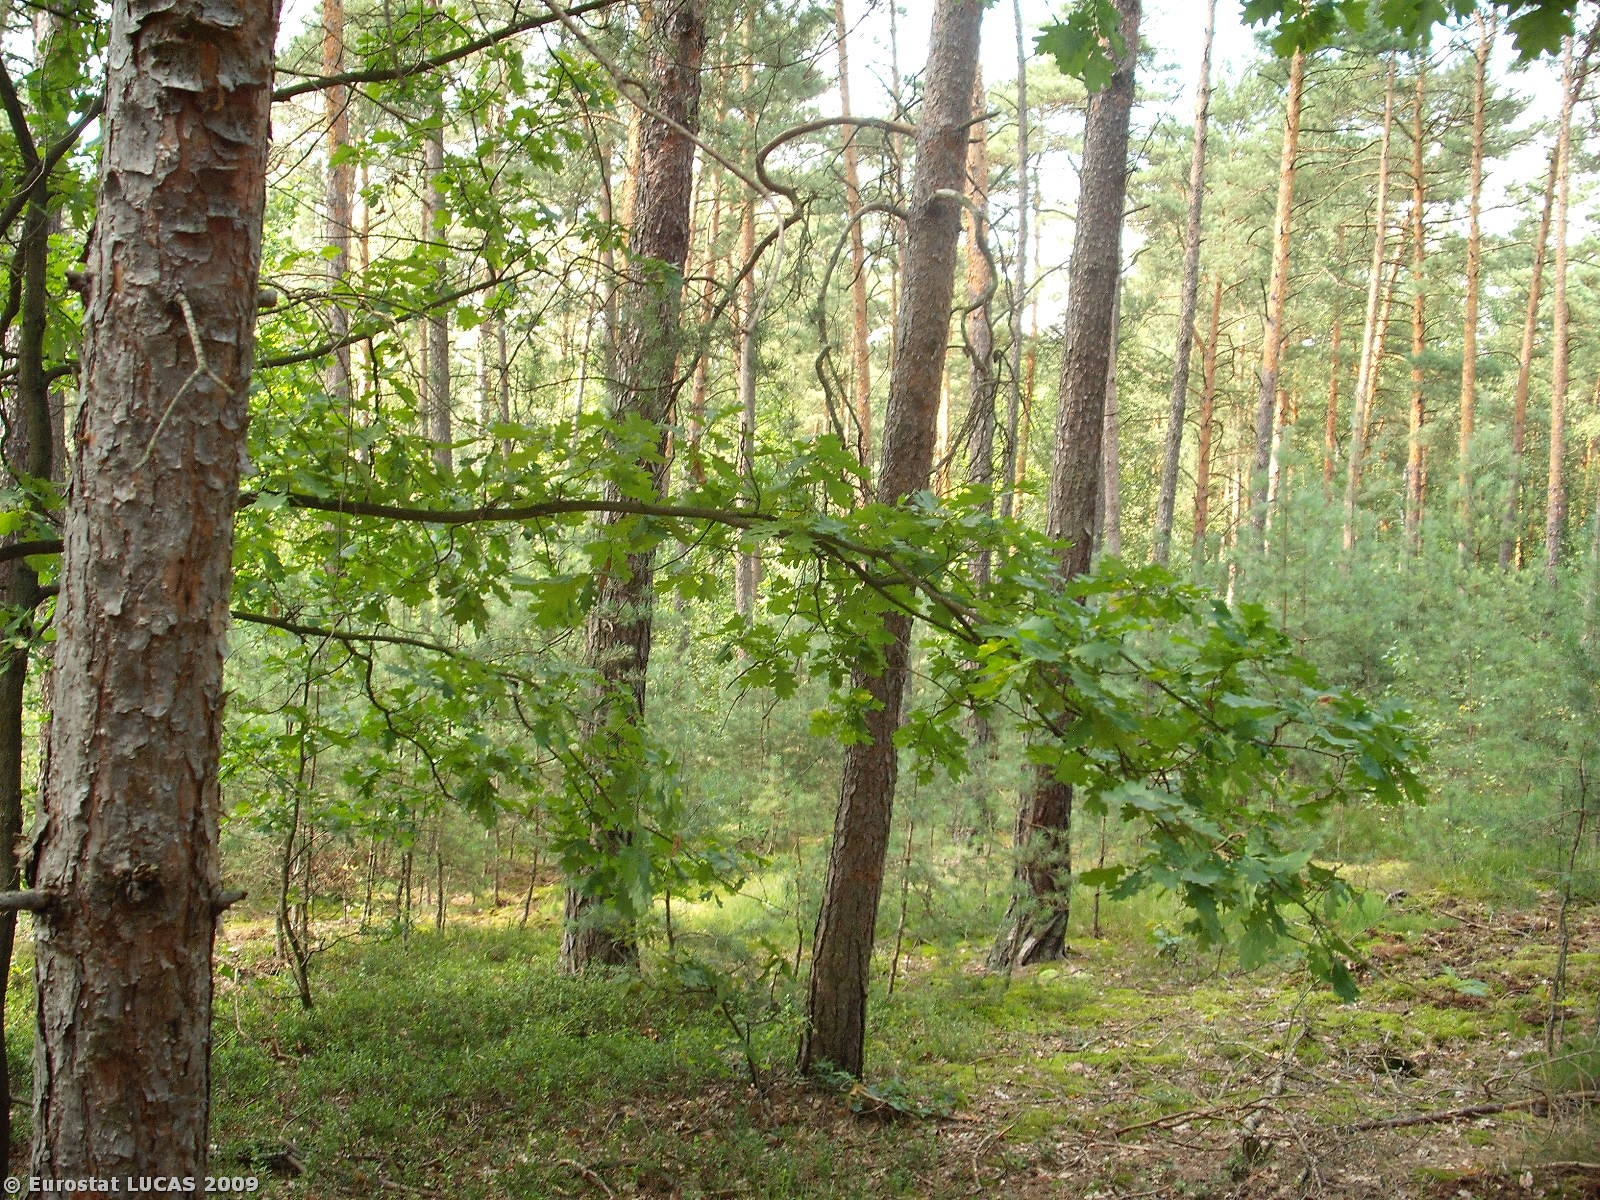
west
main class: Woodland
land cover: Coniferous woodland
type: hemiboreal forest and nemoral coniferous forest and mixed broadleaved-coniferous forest
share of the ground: > 75 %
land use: Forestry
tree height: > 5 m
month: August
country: PL
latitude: 51.7757
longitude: 21.5450
